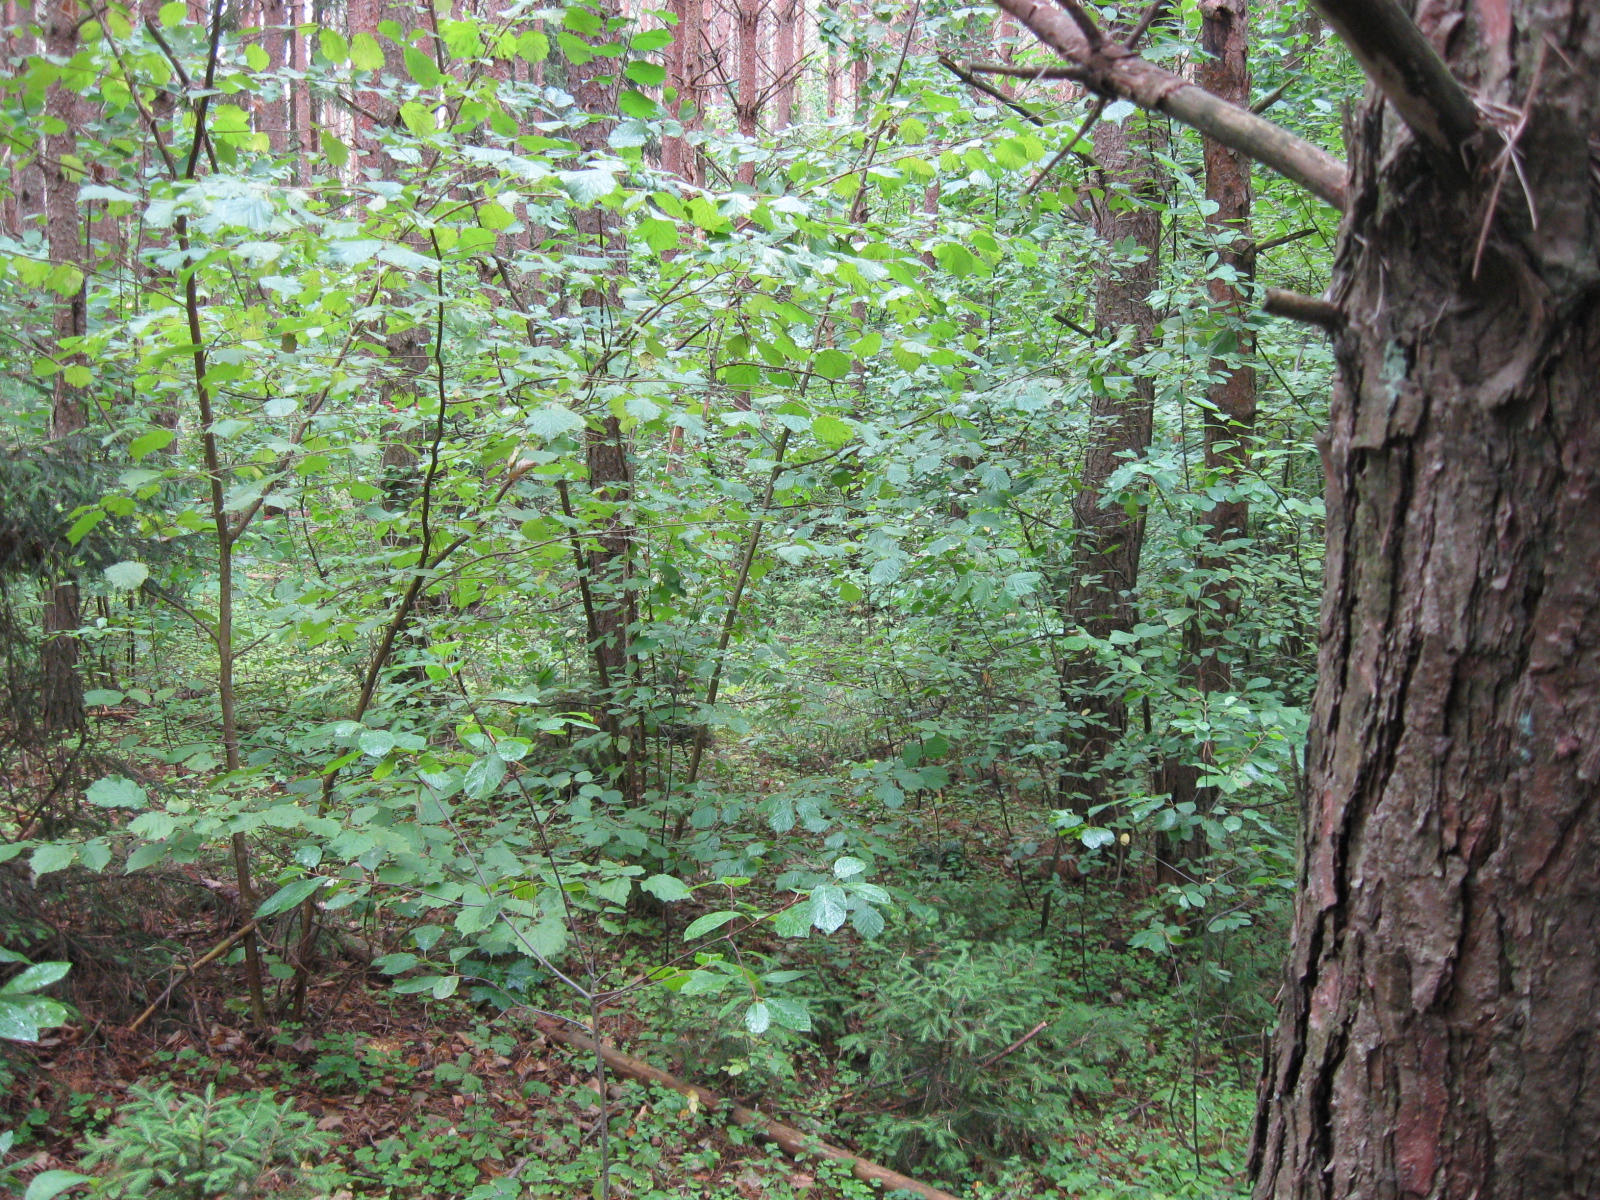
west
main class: Woodland
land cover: Pine dominated coniferous woodland
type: hemiboreal forest and nemoral coniferous forest and mixed broadleaved-coniferous forest
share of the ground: > 75 %
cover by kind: coniferous forest trees 90 %, broadleaved forest trees 5 %, herbaceous plants 5 %
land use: Forestry
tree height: > 5 m
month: July
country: LT
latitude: 54.2864
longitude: 24.2770
